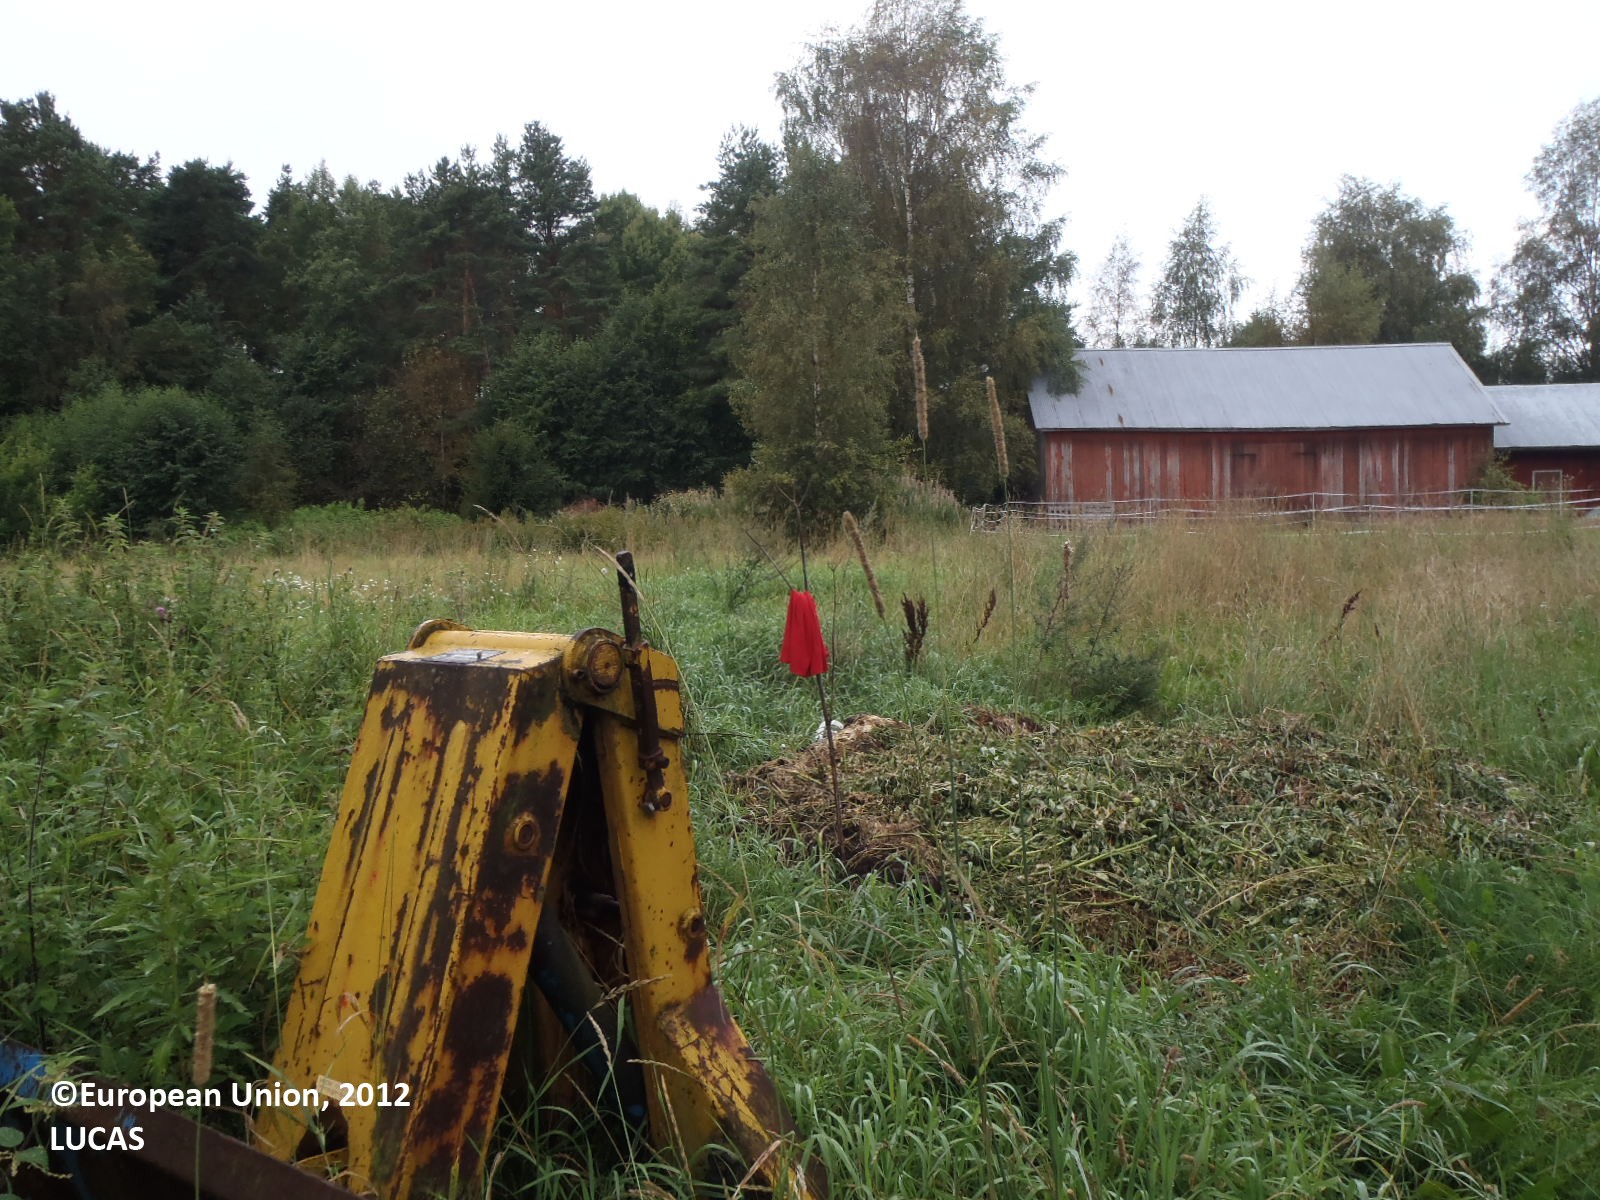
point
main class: Grassland
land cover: Grassland without tree/shrub cover
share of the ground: > 75 %
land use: Commerce, finance, business
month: August
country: FI
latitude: 60.8738
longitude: 22.3877
